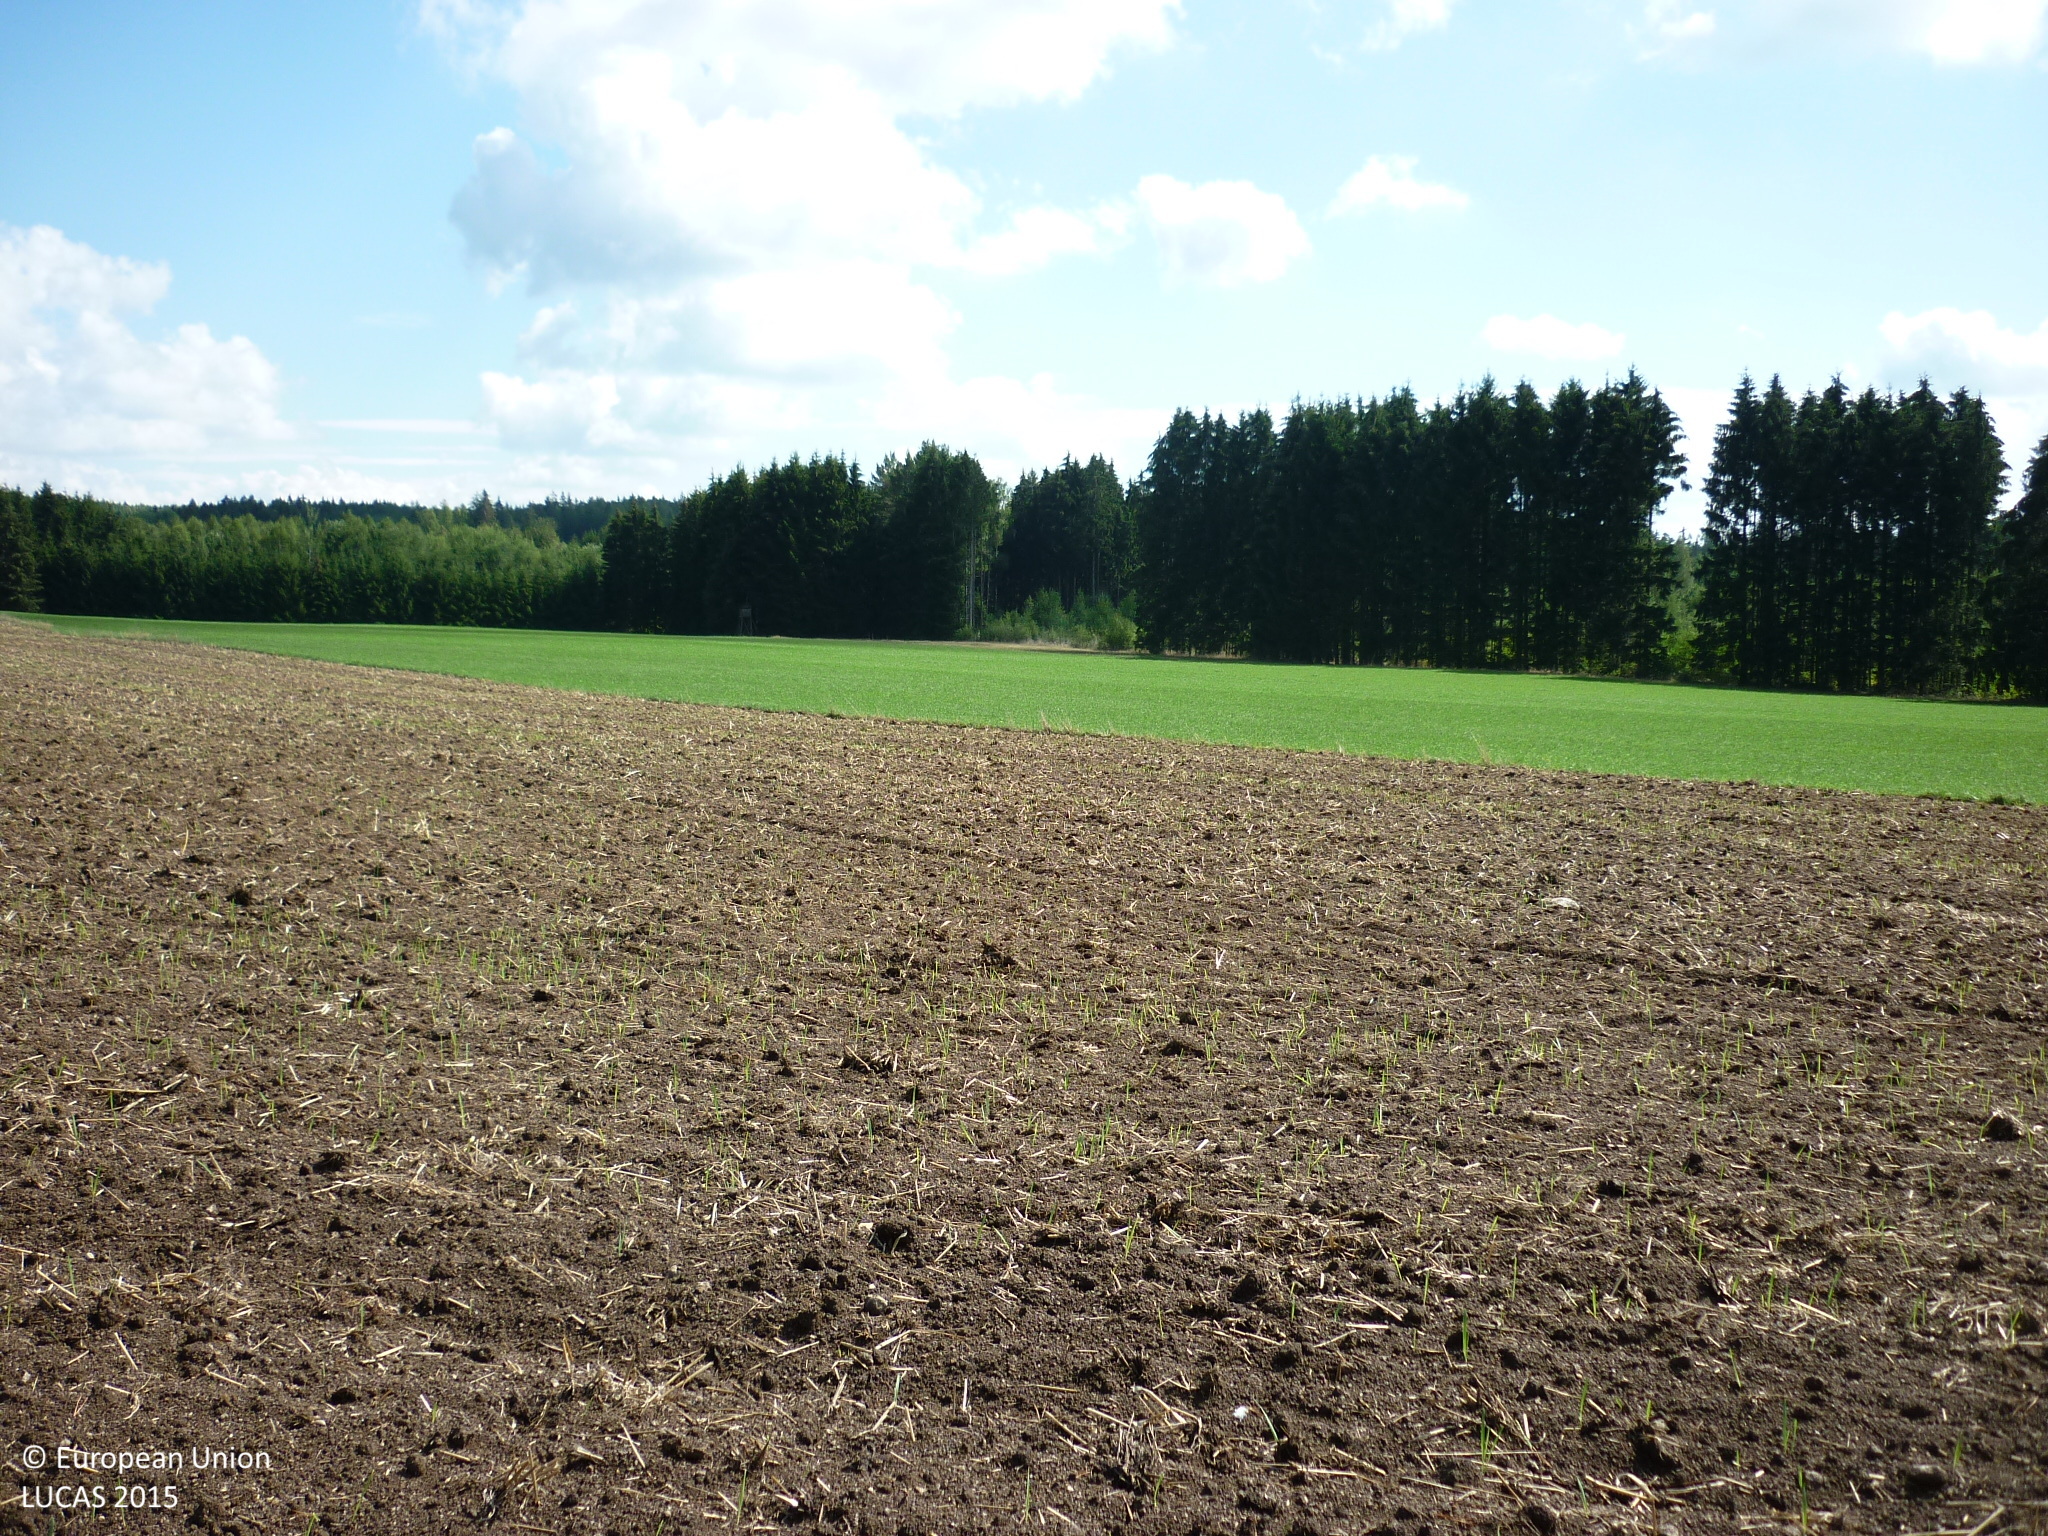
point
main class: Cropland
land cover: Rye
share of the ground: < 10 %
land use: Agriculture (excluding fallow land and kitchen gardens)
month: September
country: AT
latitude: 48.9710
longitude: 15.0978
